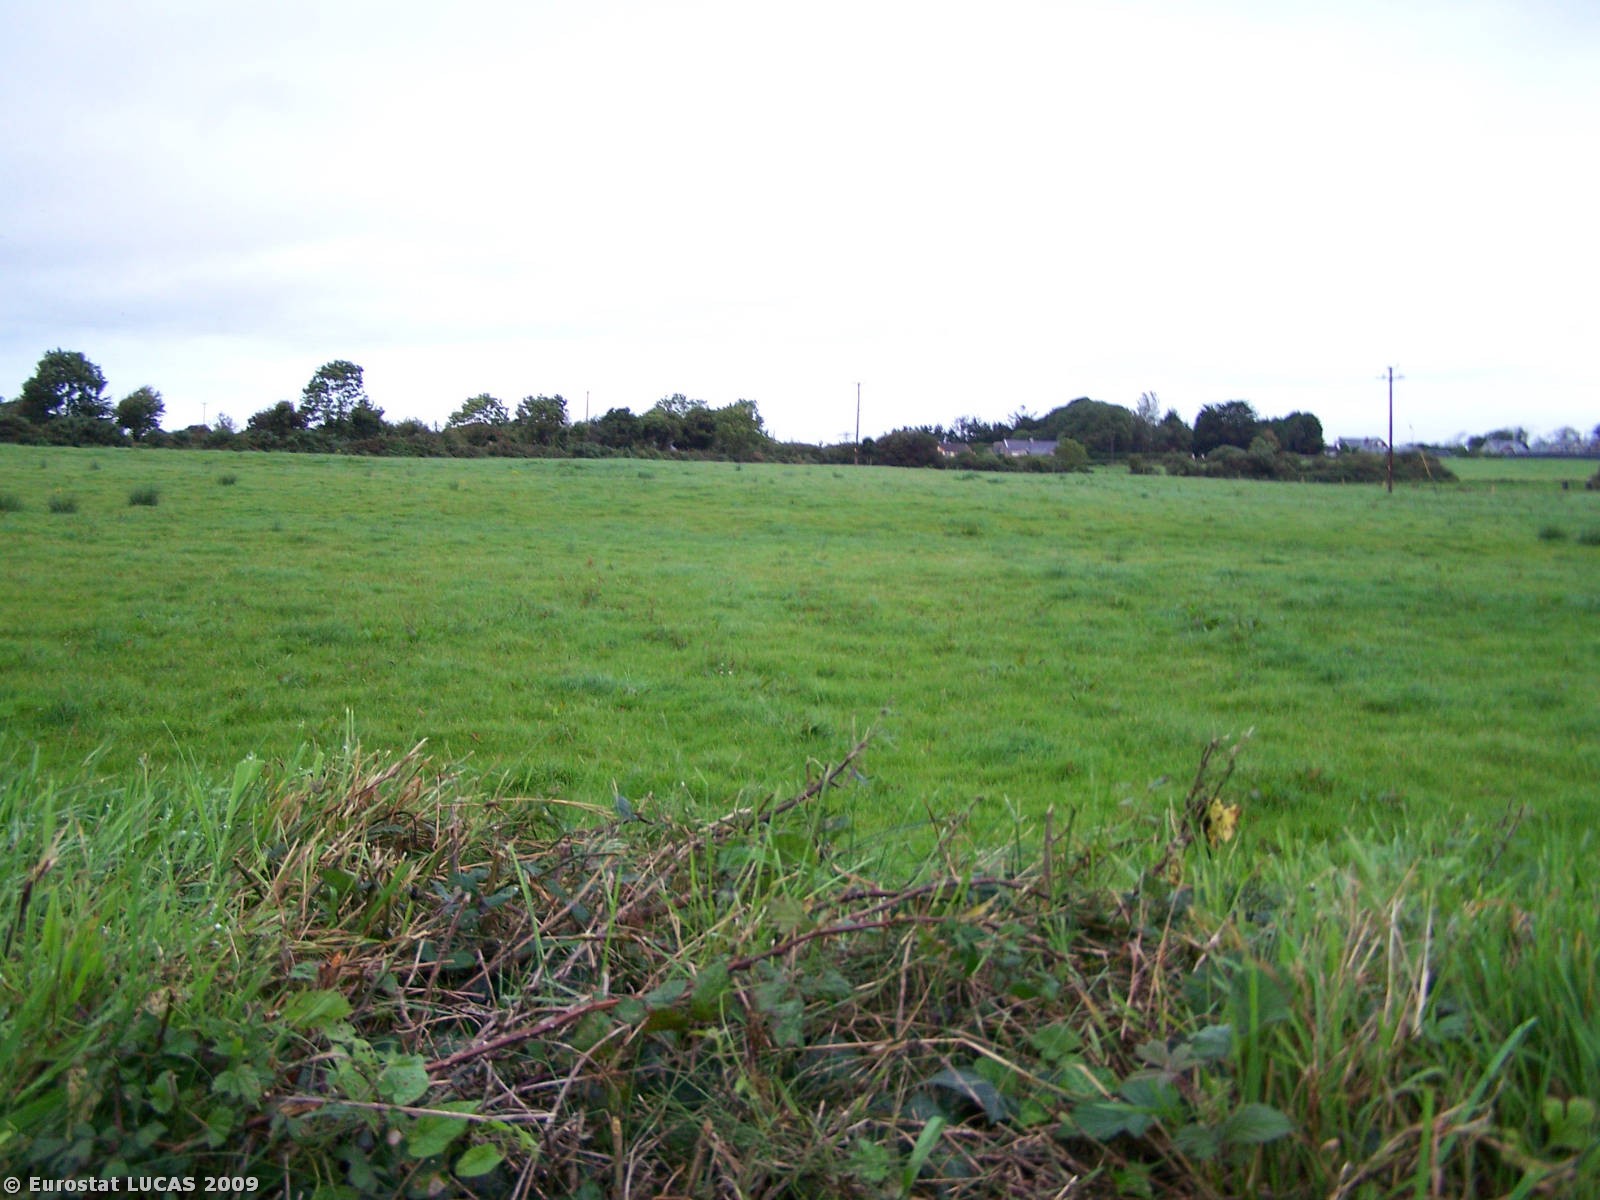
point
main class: Grassland
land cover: Grassland without tree/shrub cover
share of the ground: > 75 %
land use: Agriculture (excluding fallow land and kitchen gardens)
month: September
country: IE
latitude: 52.2841
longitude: -9.6630
